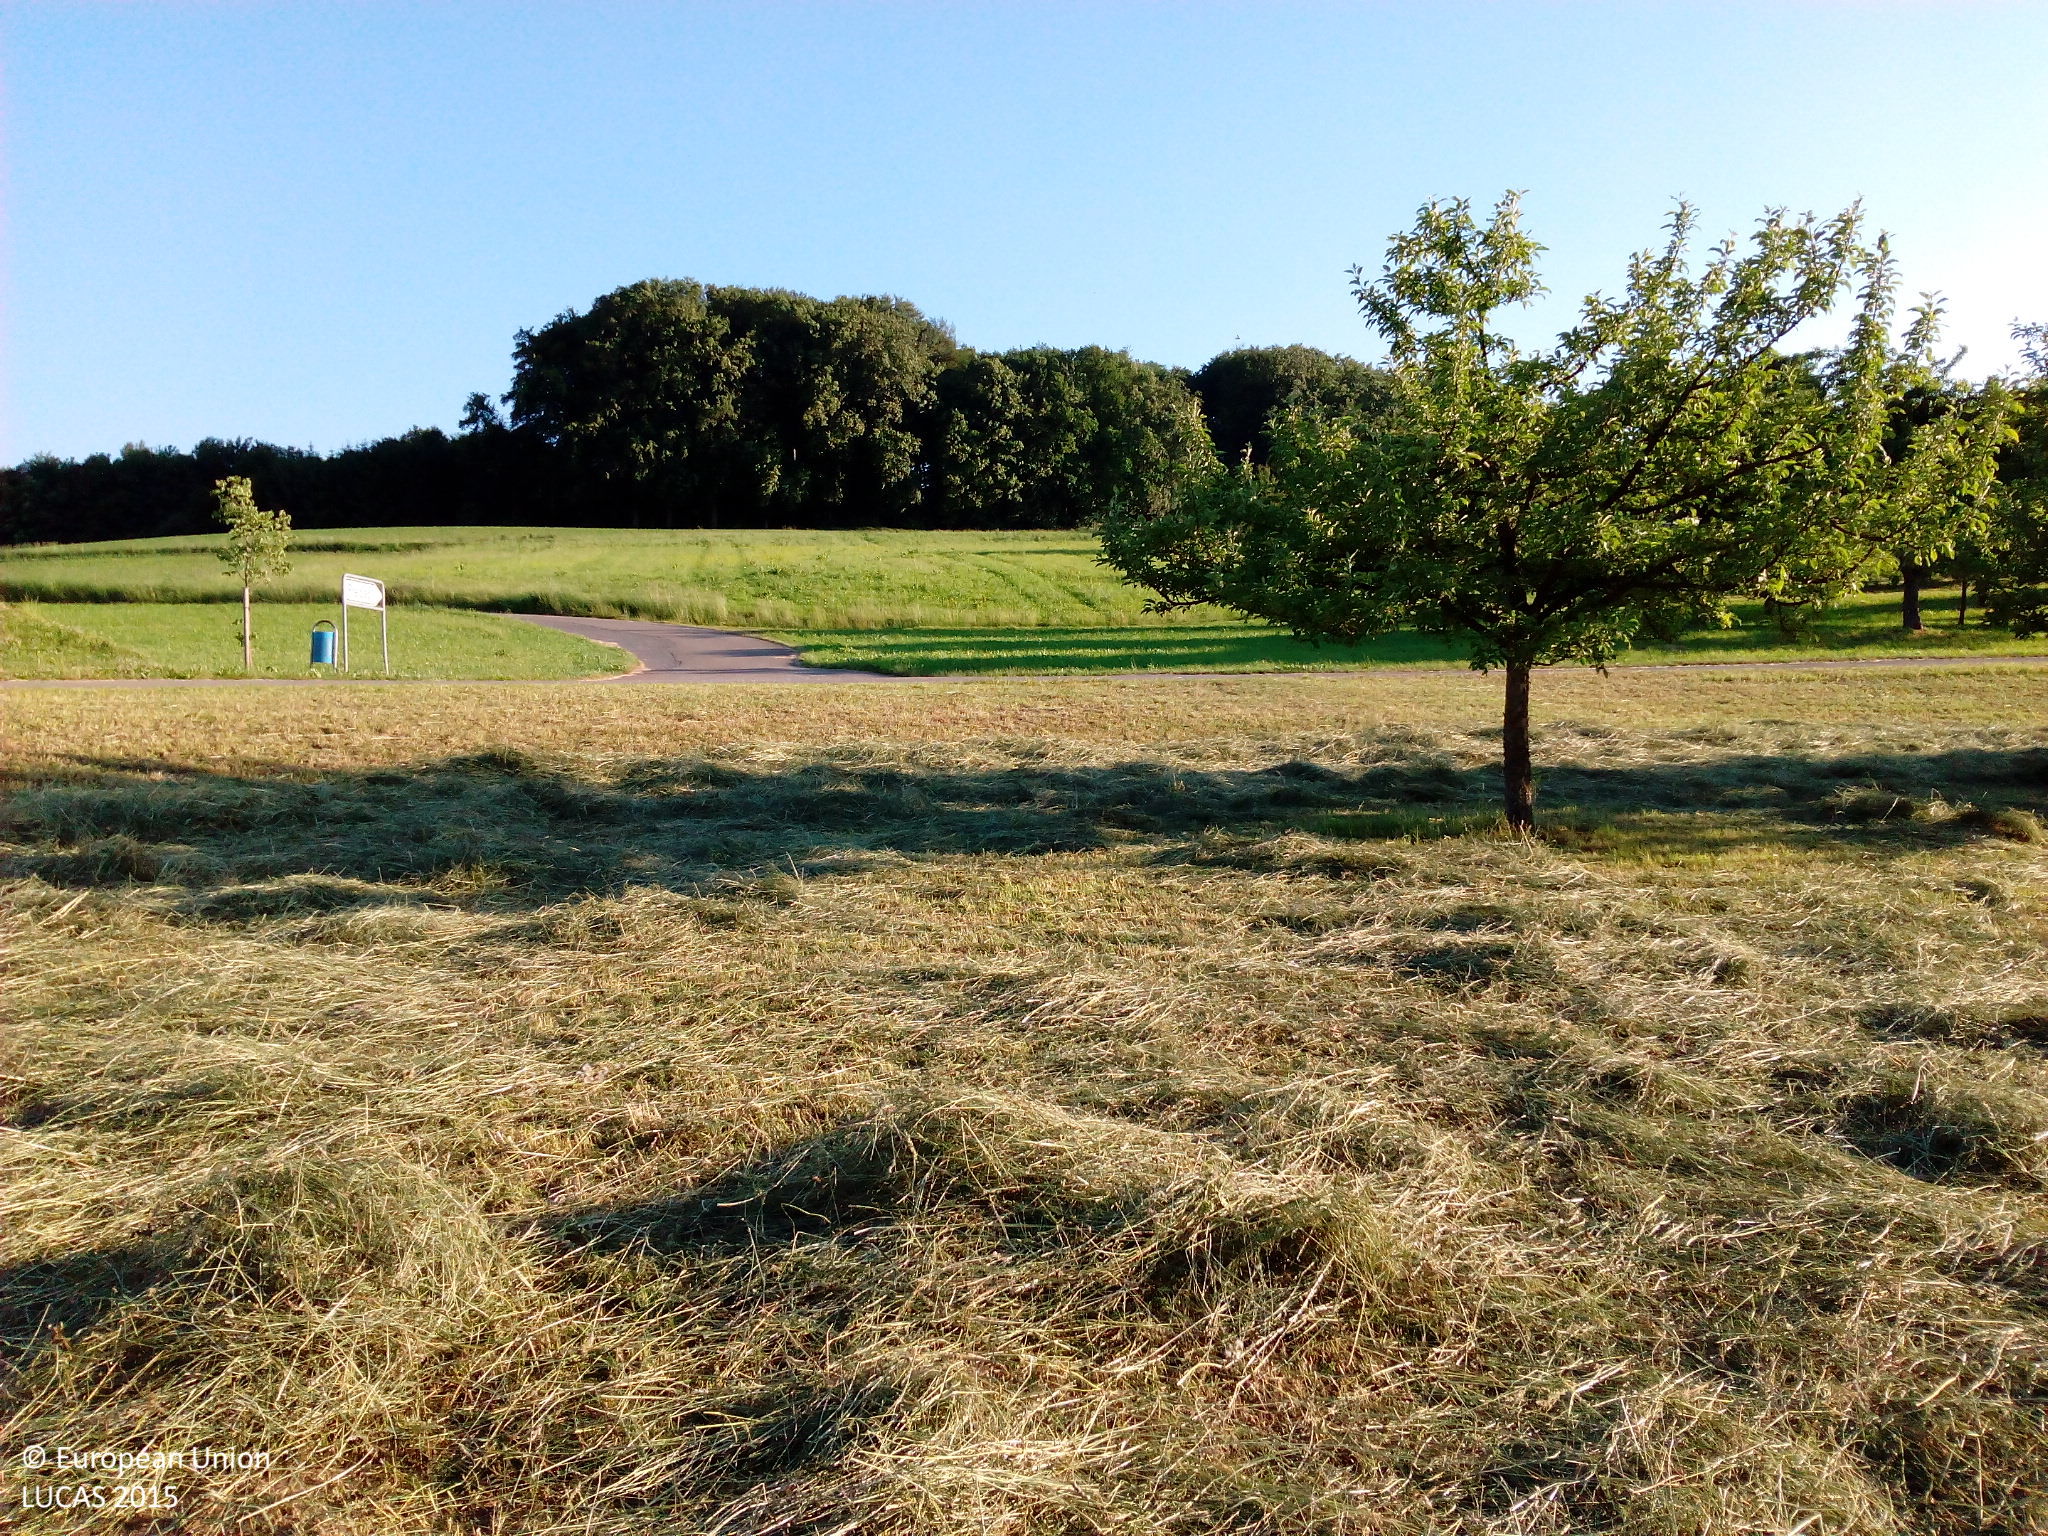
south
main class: Grassland
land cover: Grassland without tree/shrub cover
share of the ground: > 75 %
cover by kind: herbaceous plants 100 %
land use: Agriculture (excluding fallow land and kitchen gardens)
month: June
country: DE
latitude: 48.9235
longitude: 9.3861
